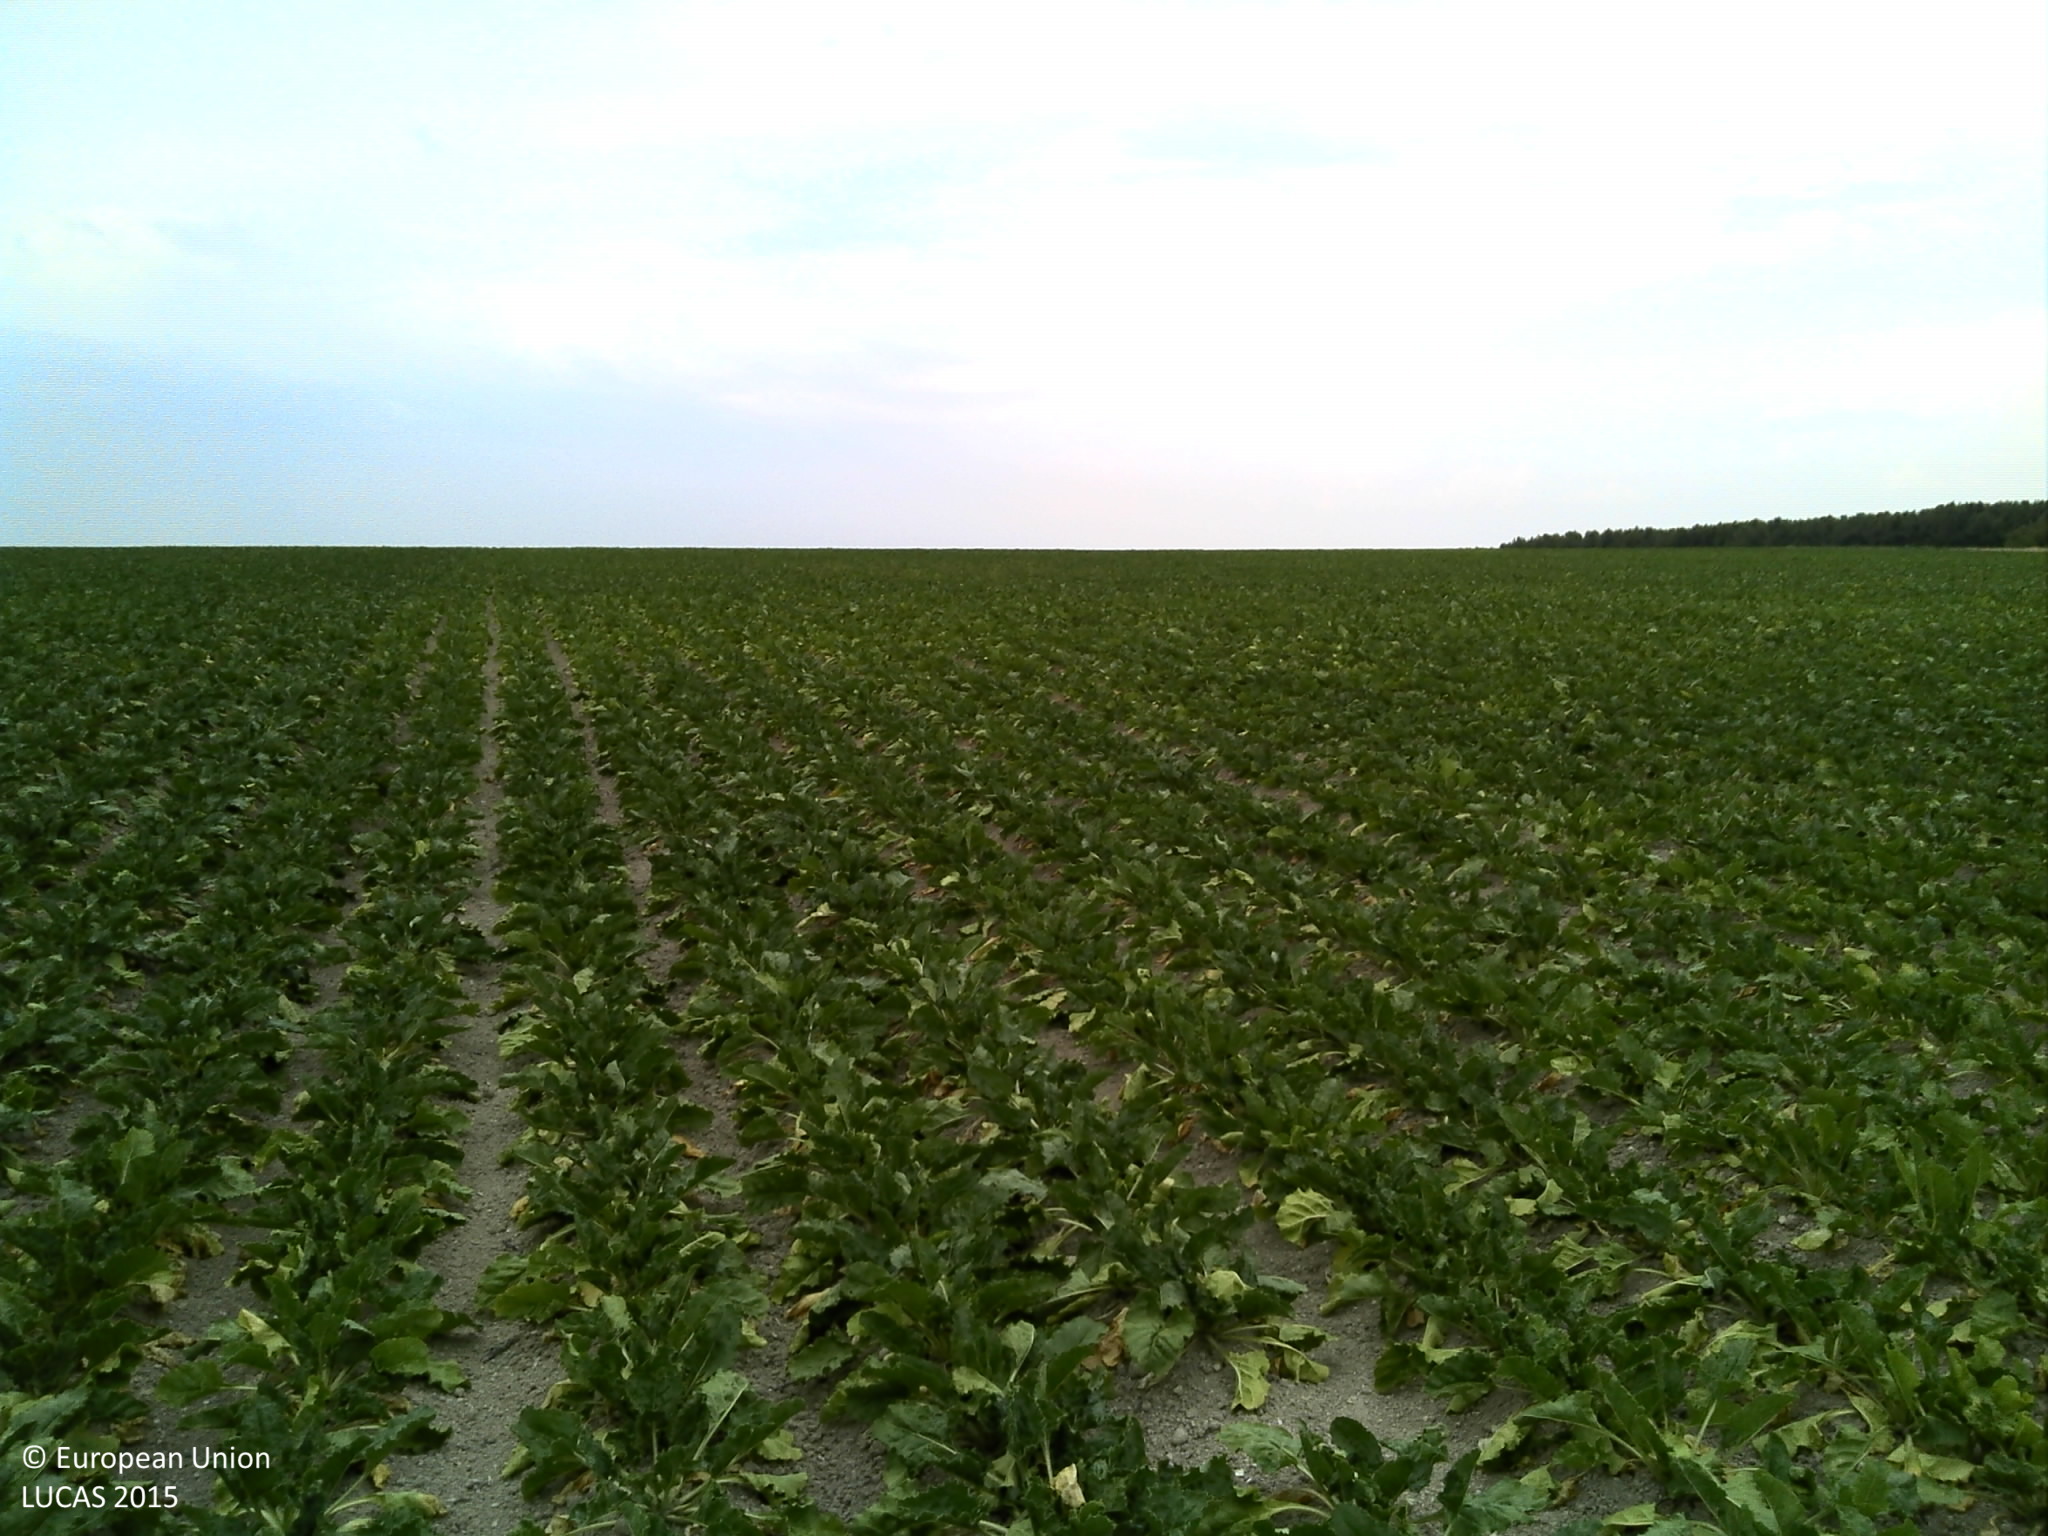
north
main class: Cropland
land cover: Sugar beet
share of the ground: 50 - 75 %
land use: Agriculture (excluding fallow land and kitchen gardens)
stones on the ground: < 10 %
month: August
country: FR
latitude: 48.9378
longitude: 4.2212
